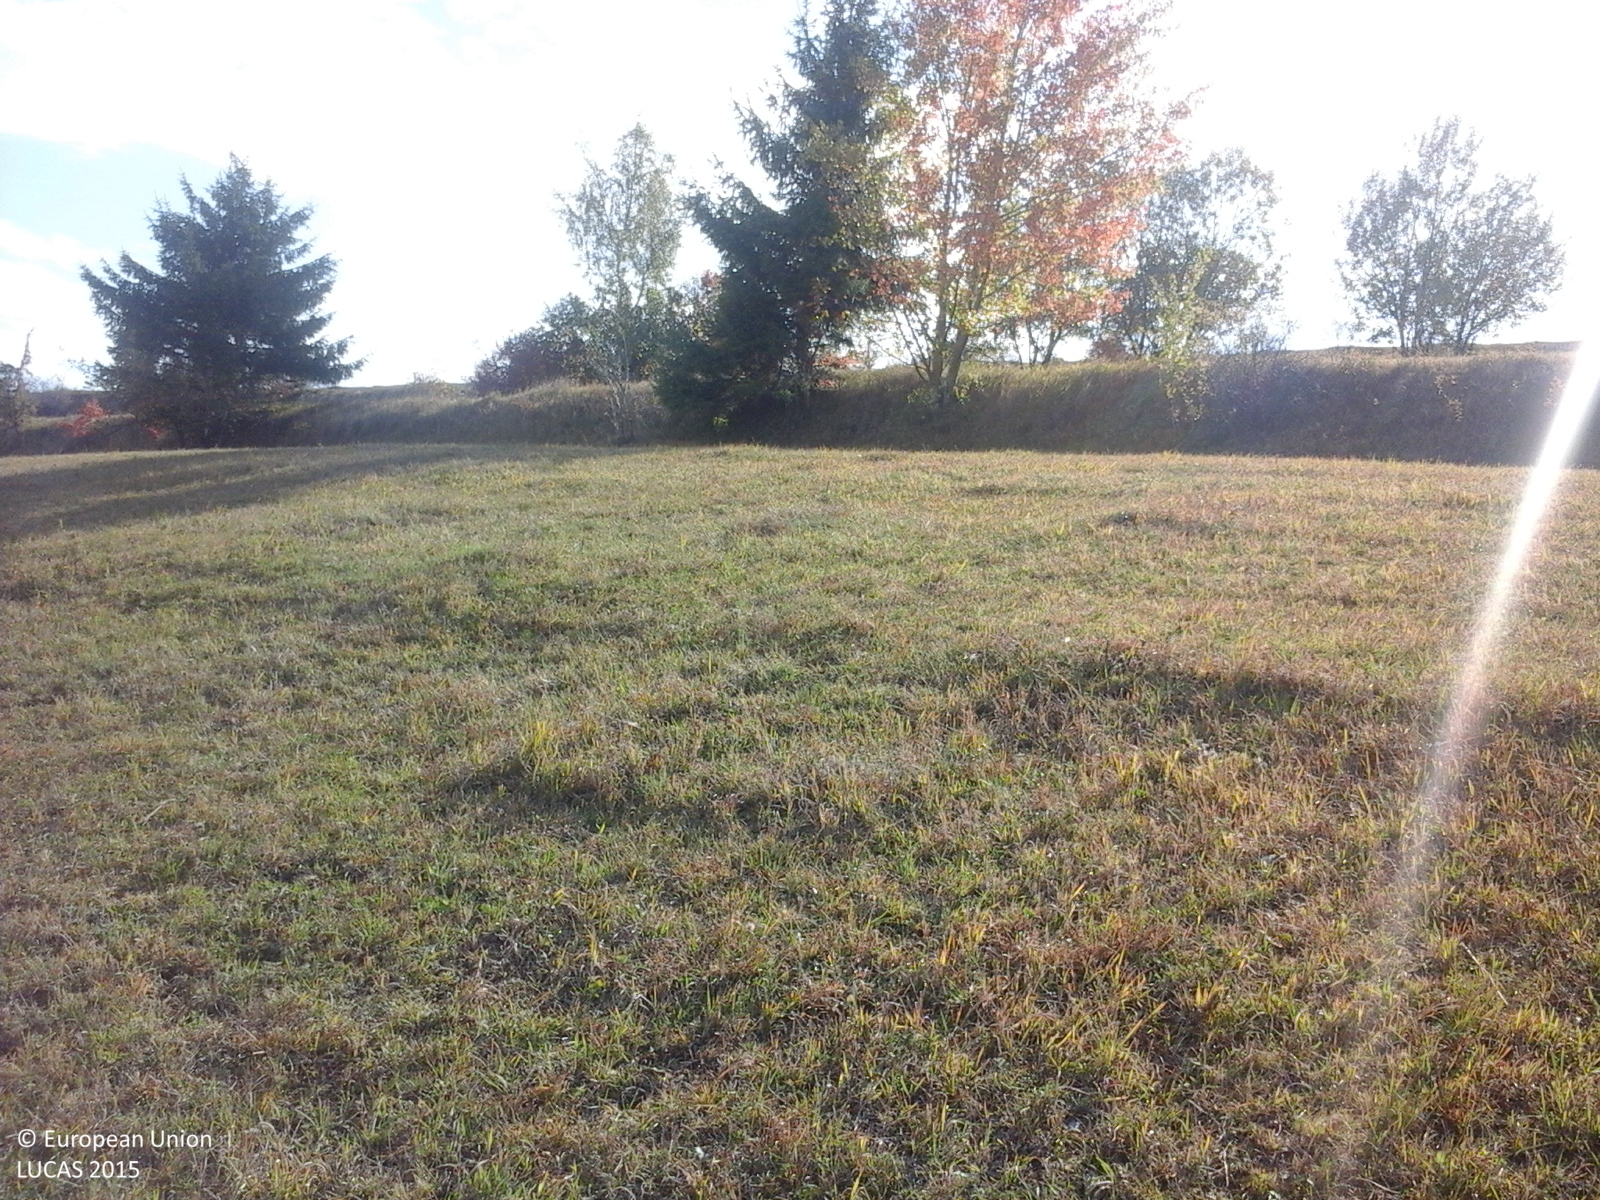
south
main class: Grassland
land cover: Grassland without tree/shrub cover
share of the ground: > 75 %
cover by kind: herbaceous plants 100 %
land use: Agriculture (excluding fallow land and kitchen gardens)
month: October
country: RO
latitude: 46.3225
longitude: 25.9243
